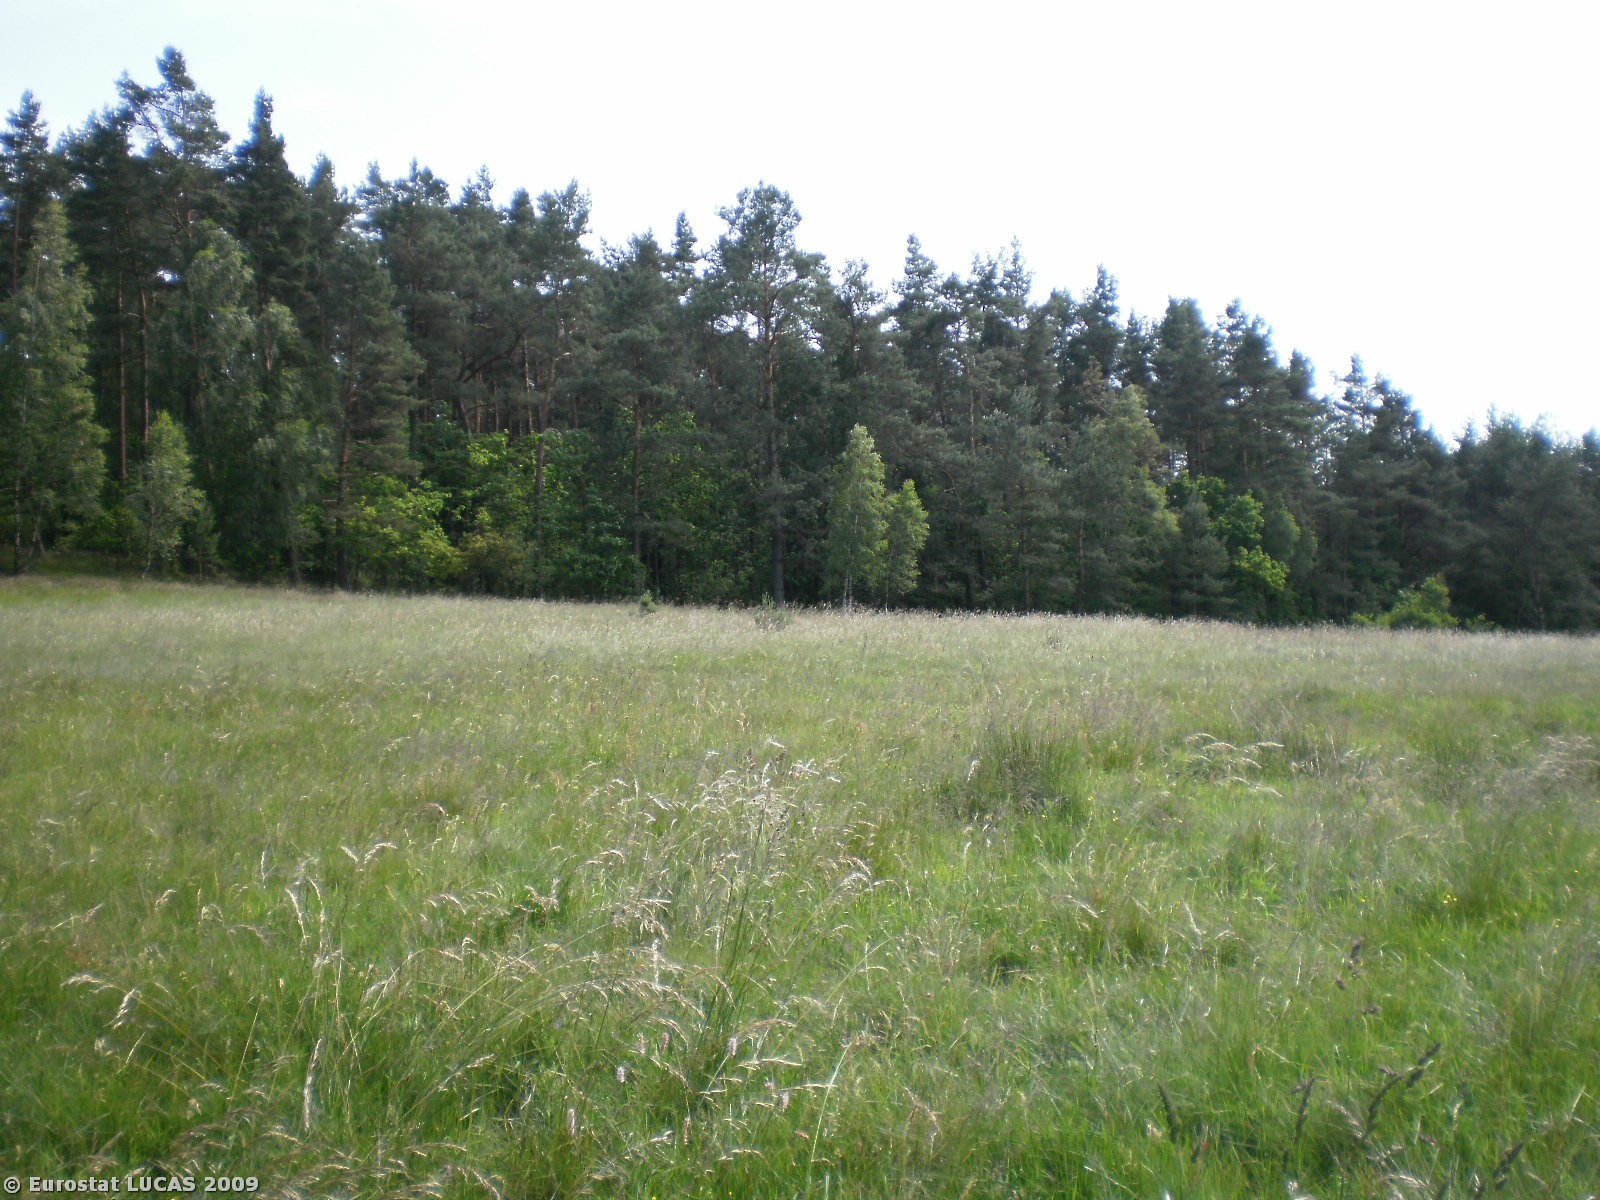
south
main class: Grassland
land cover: Grassland with sparse tree/shrub cover
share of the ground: > 75 %
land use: Agriculture (excluding fallow land and kitchen gardens)
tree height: < 5 m
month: June
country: PL
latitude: 54.3914
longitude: 17.2939
